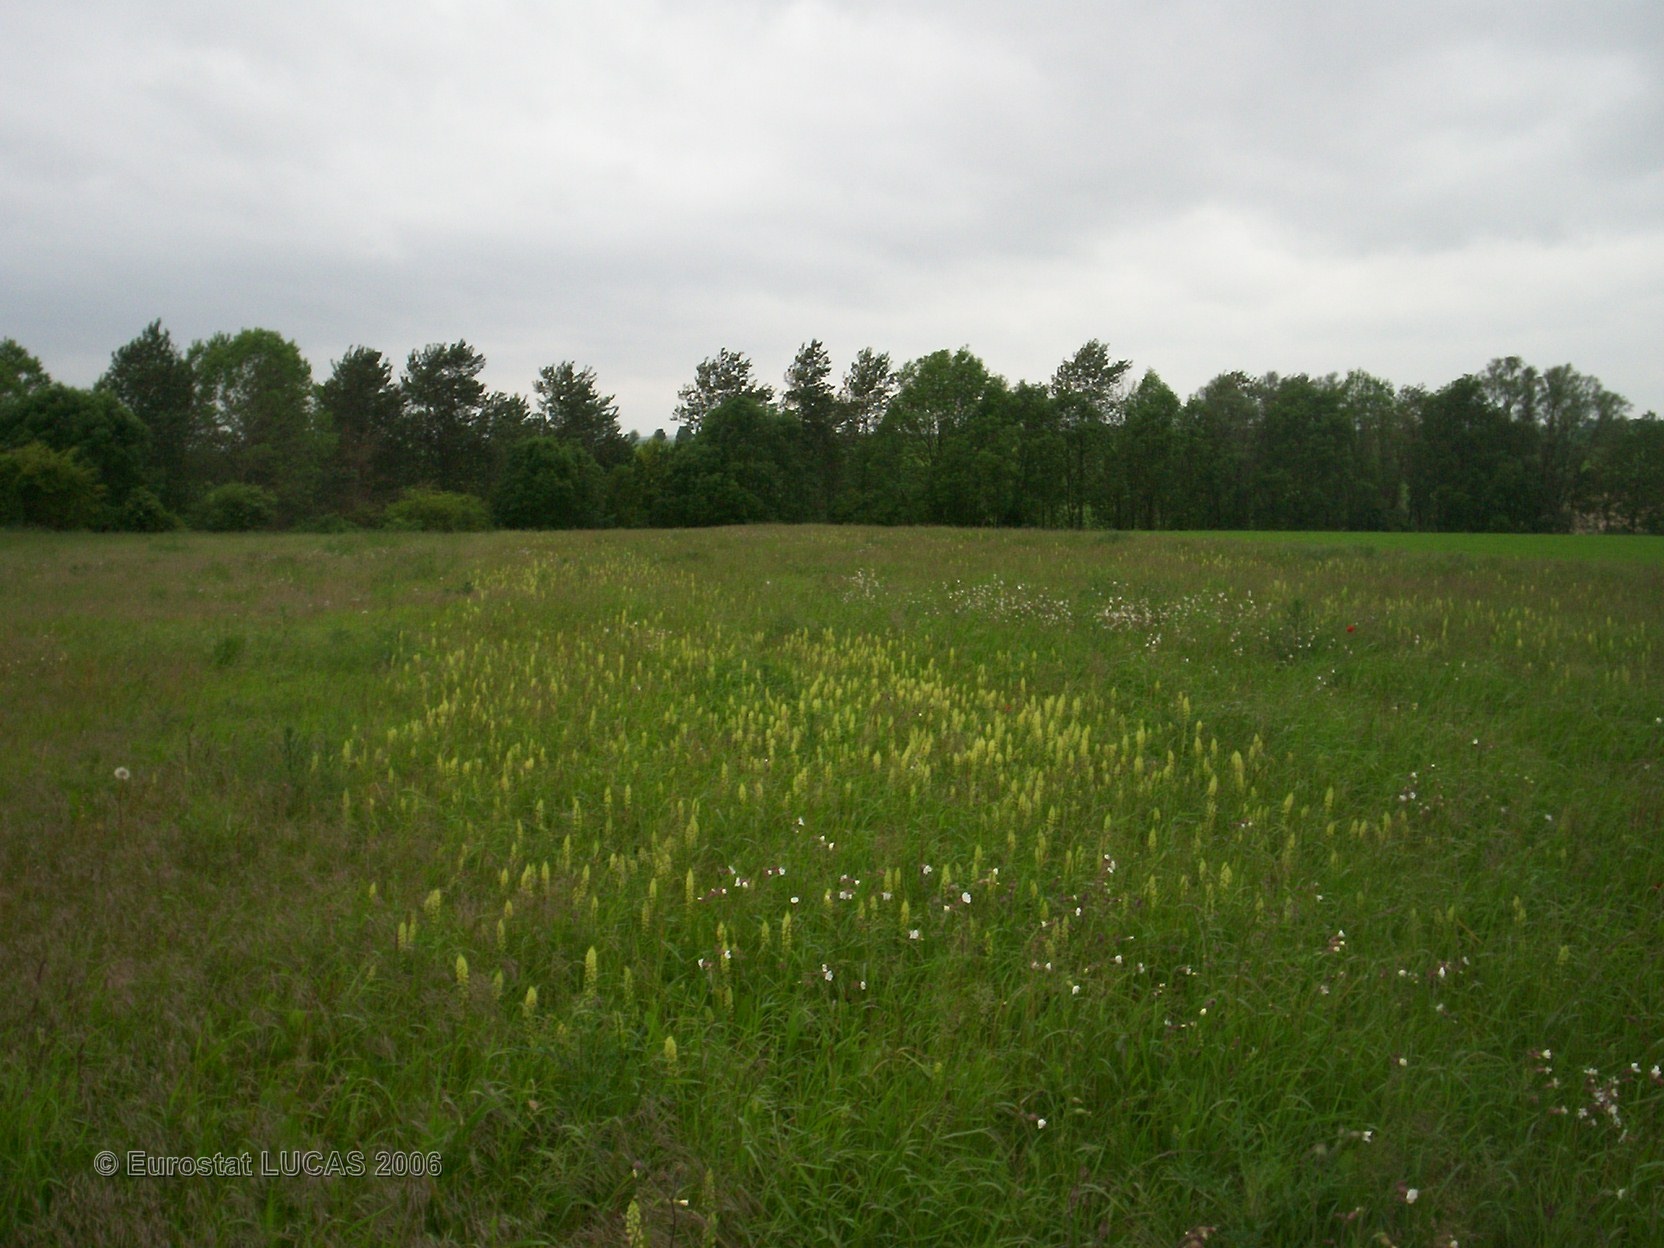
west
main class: Grassland
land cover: Grassland without tree/shrub cover
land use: Fallow land
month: May
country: FR
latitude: 49.3088
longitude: 4.4257
